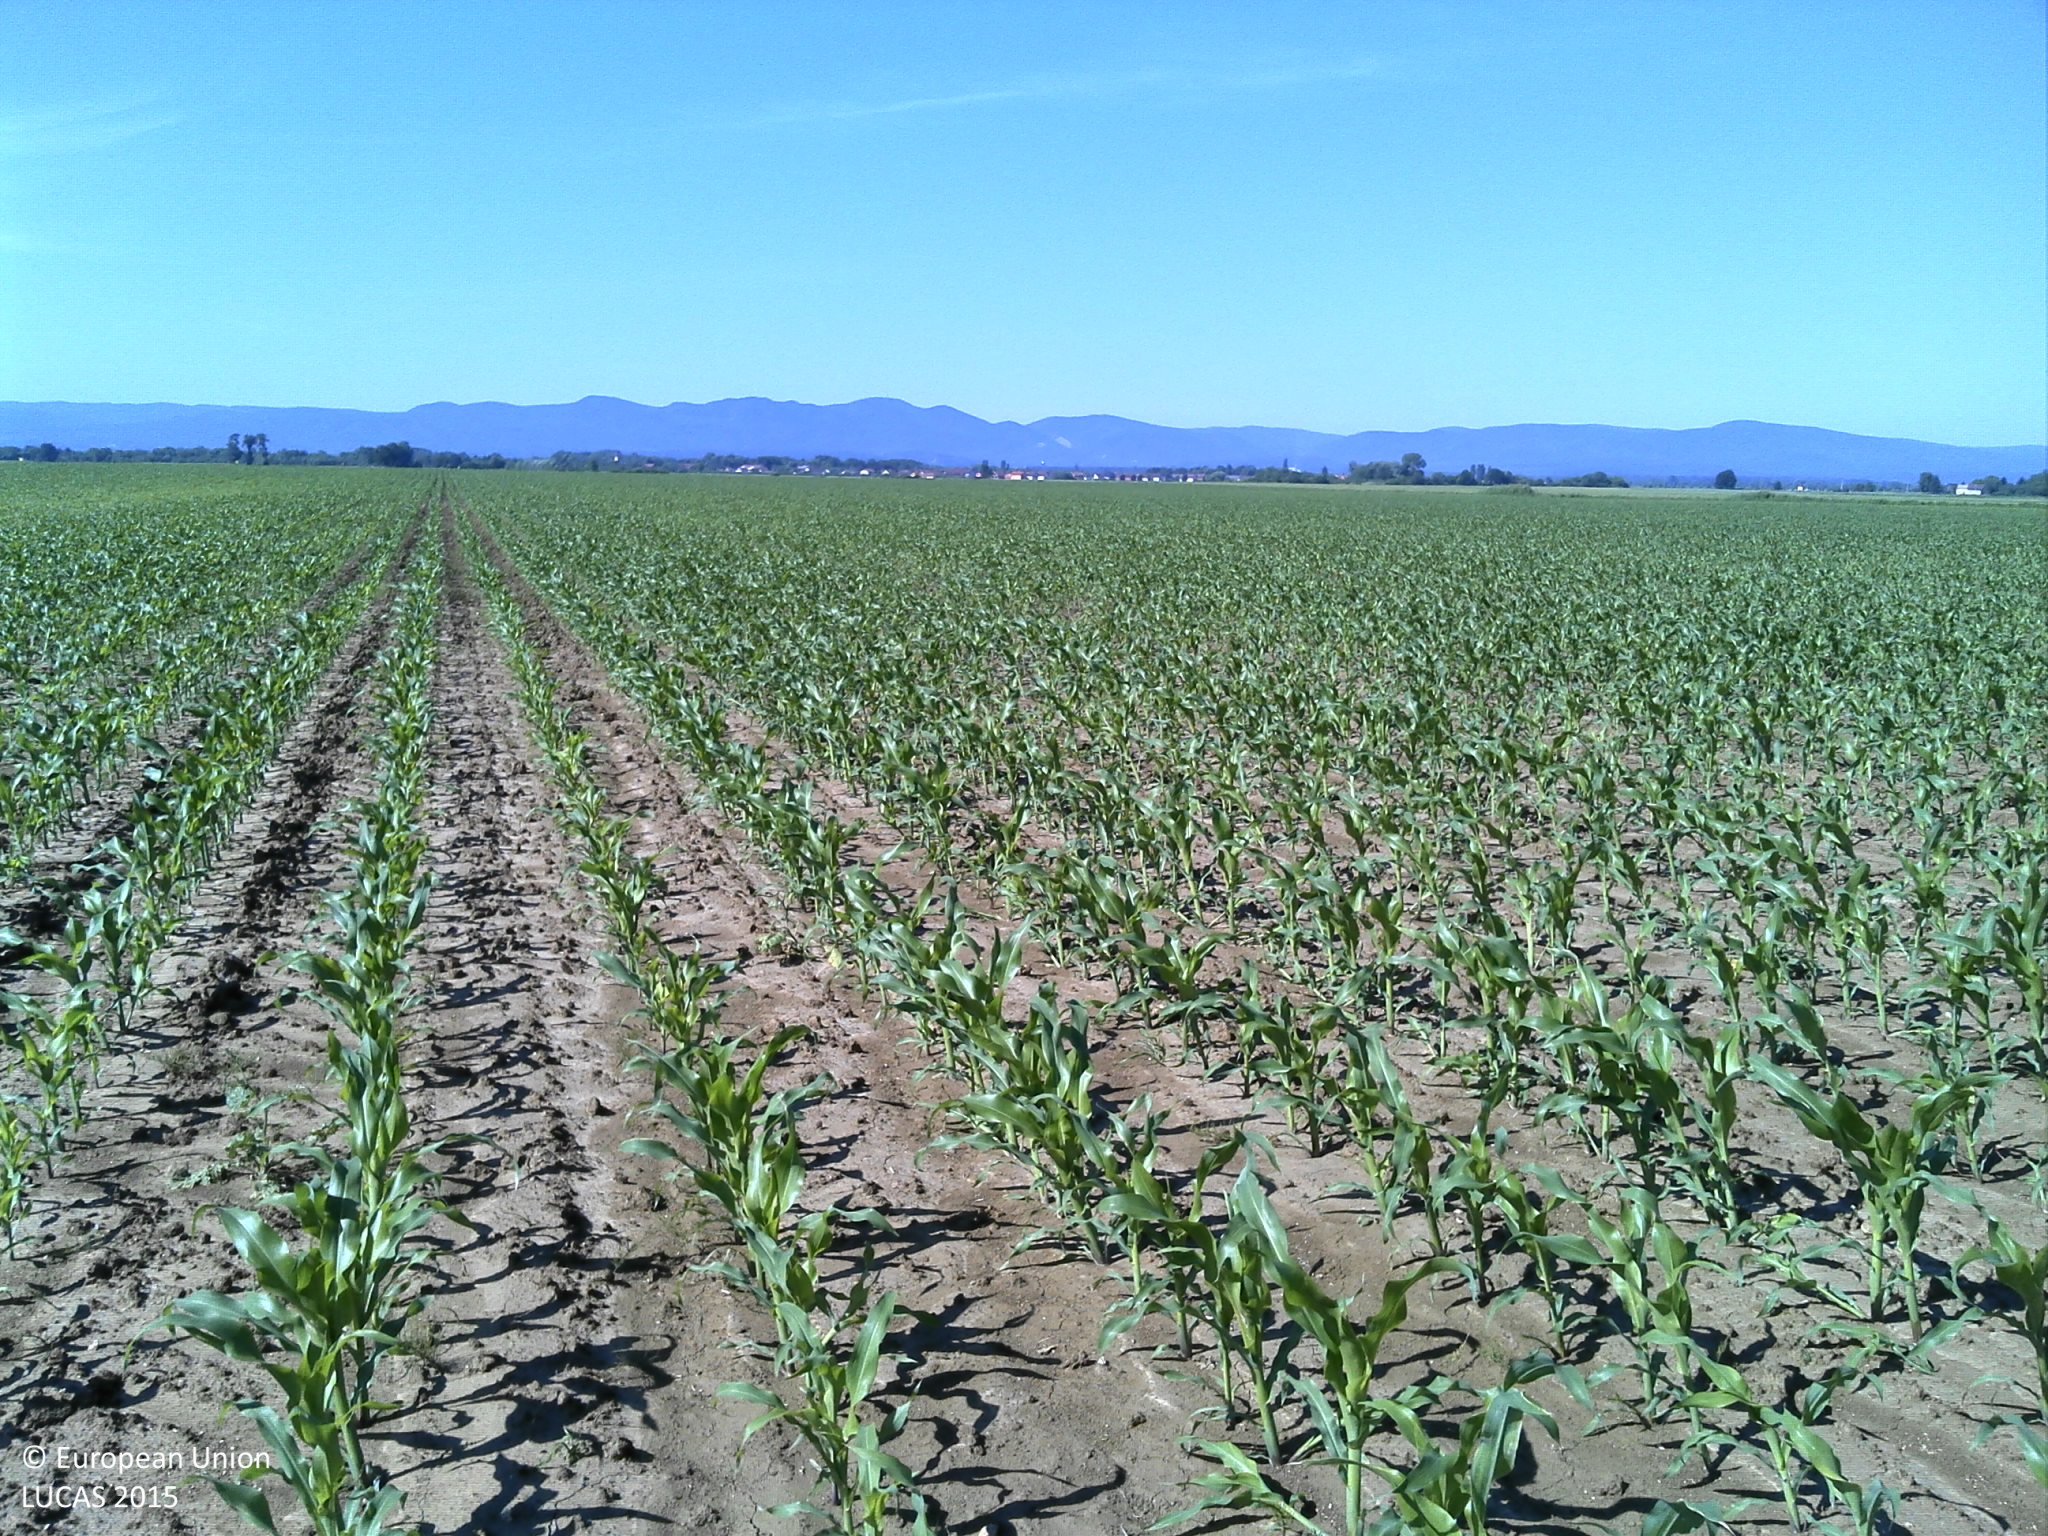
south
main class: Cropland
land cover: Maize
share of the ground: 50 - 75 %
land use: Agriculture (excluding fallow land and kitchen gardens)
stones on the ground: < 10 %
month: May
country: HR
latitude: 45.6014
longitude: 17.9656
